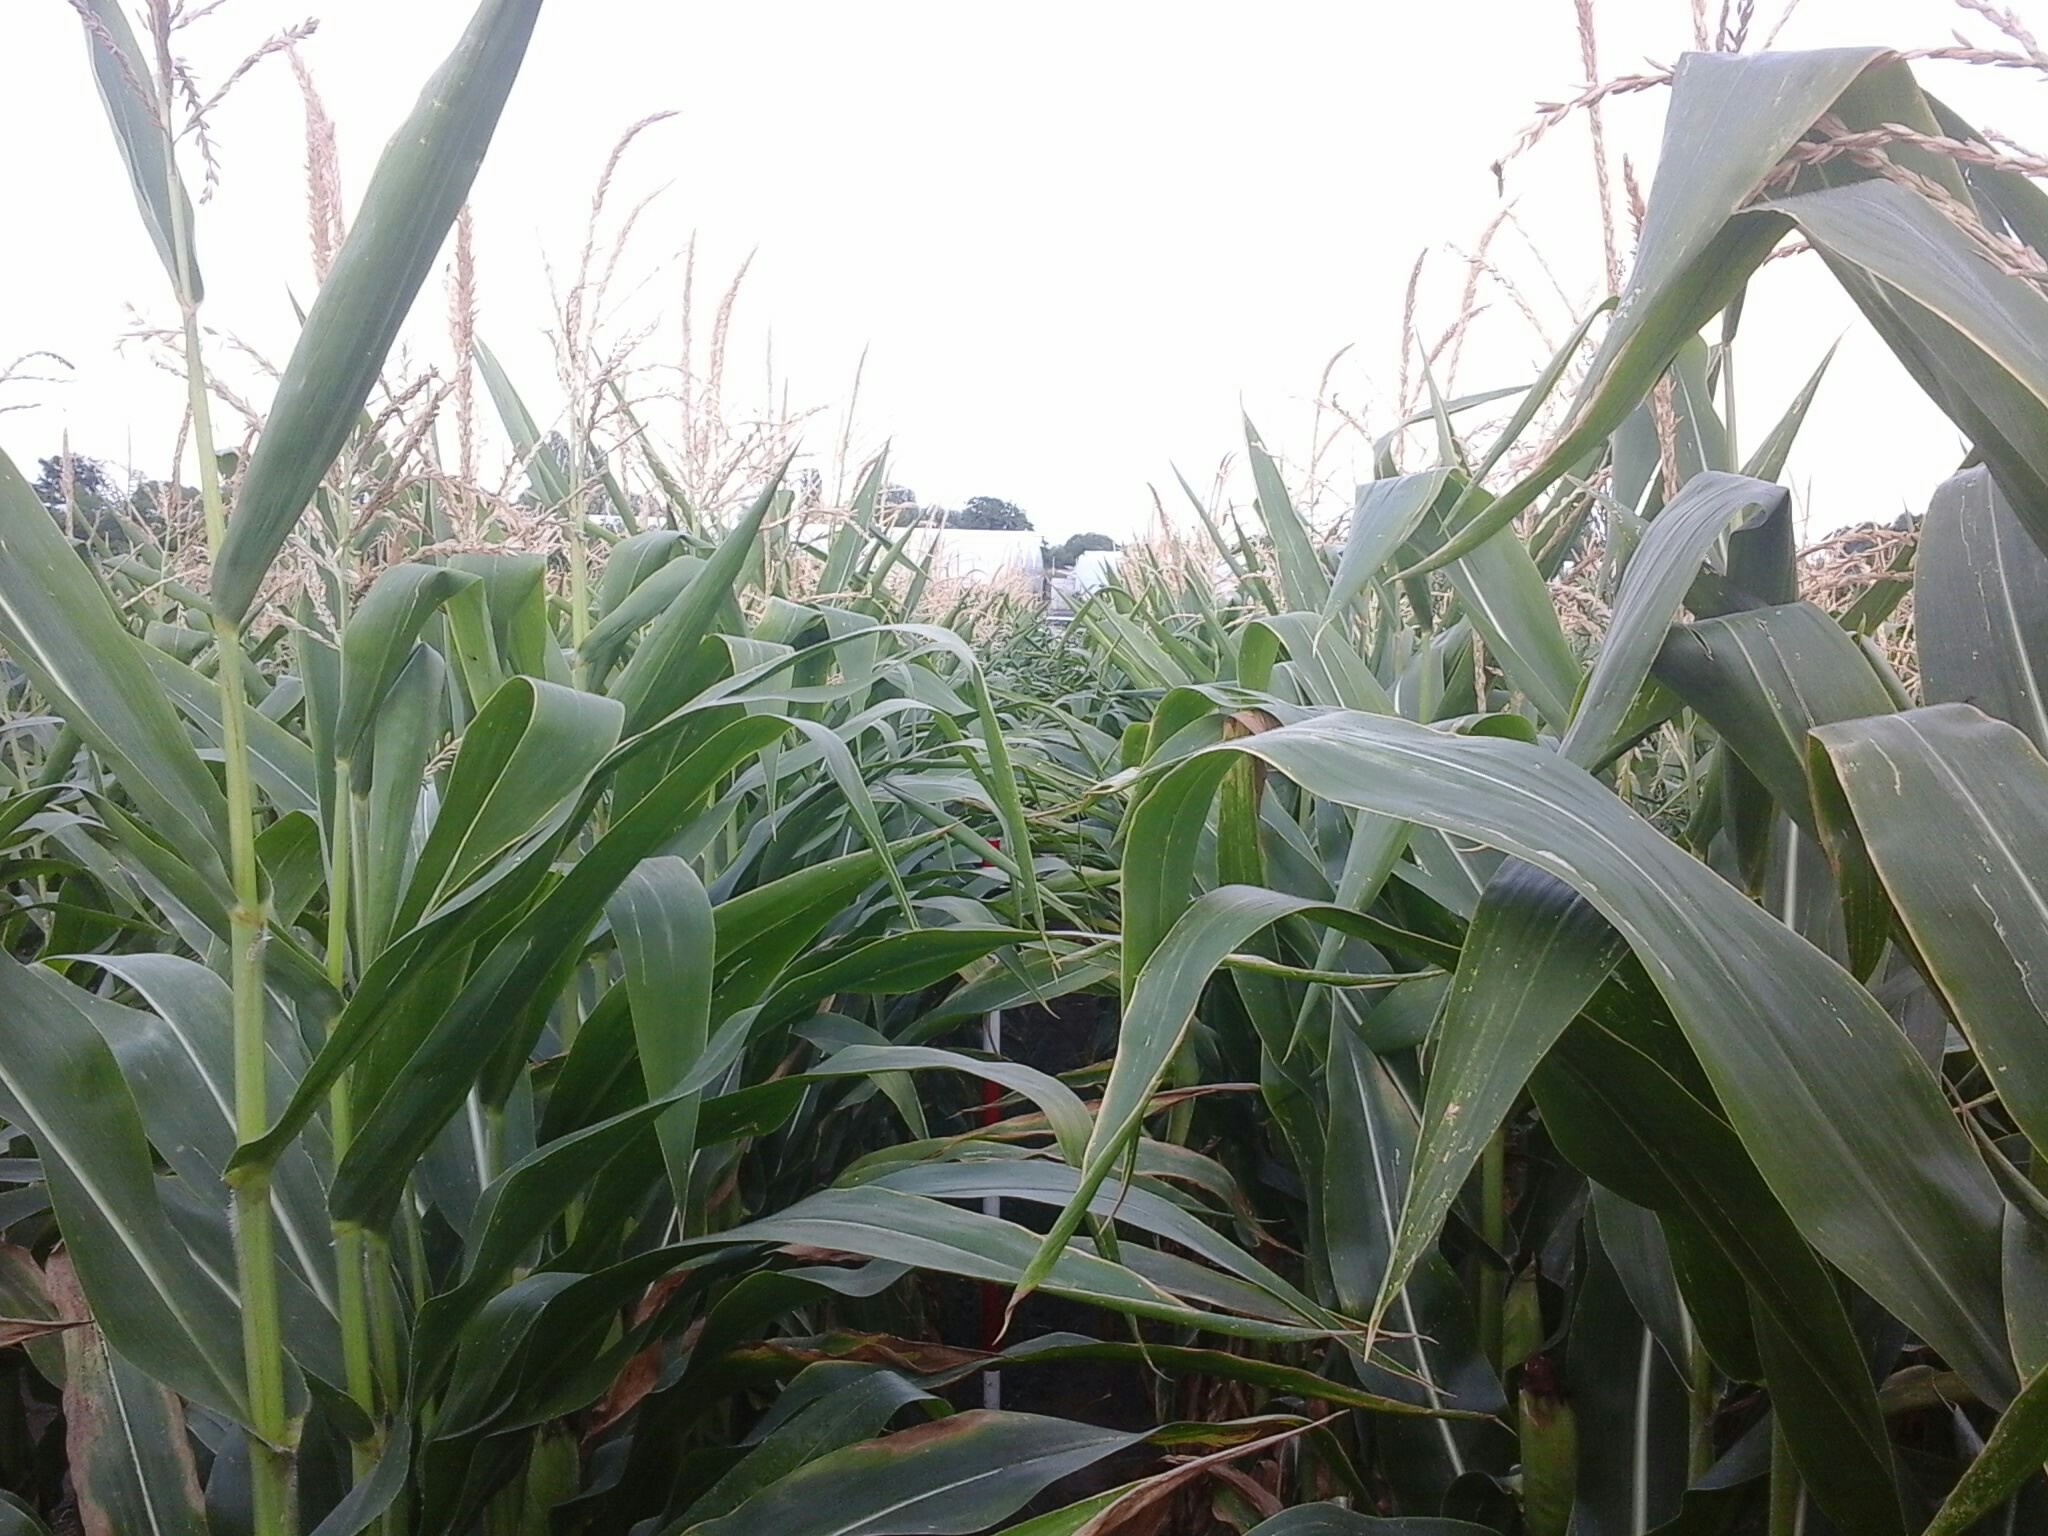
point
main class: Cropland
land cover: Maize
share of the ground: > 75 %
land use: Agriculture (excluding fallow land and kitchen gardens)
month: August
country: HU
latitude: 47.5054
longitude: 18.1502
